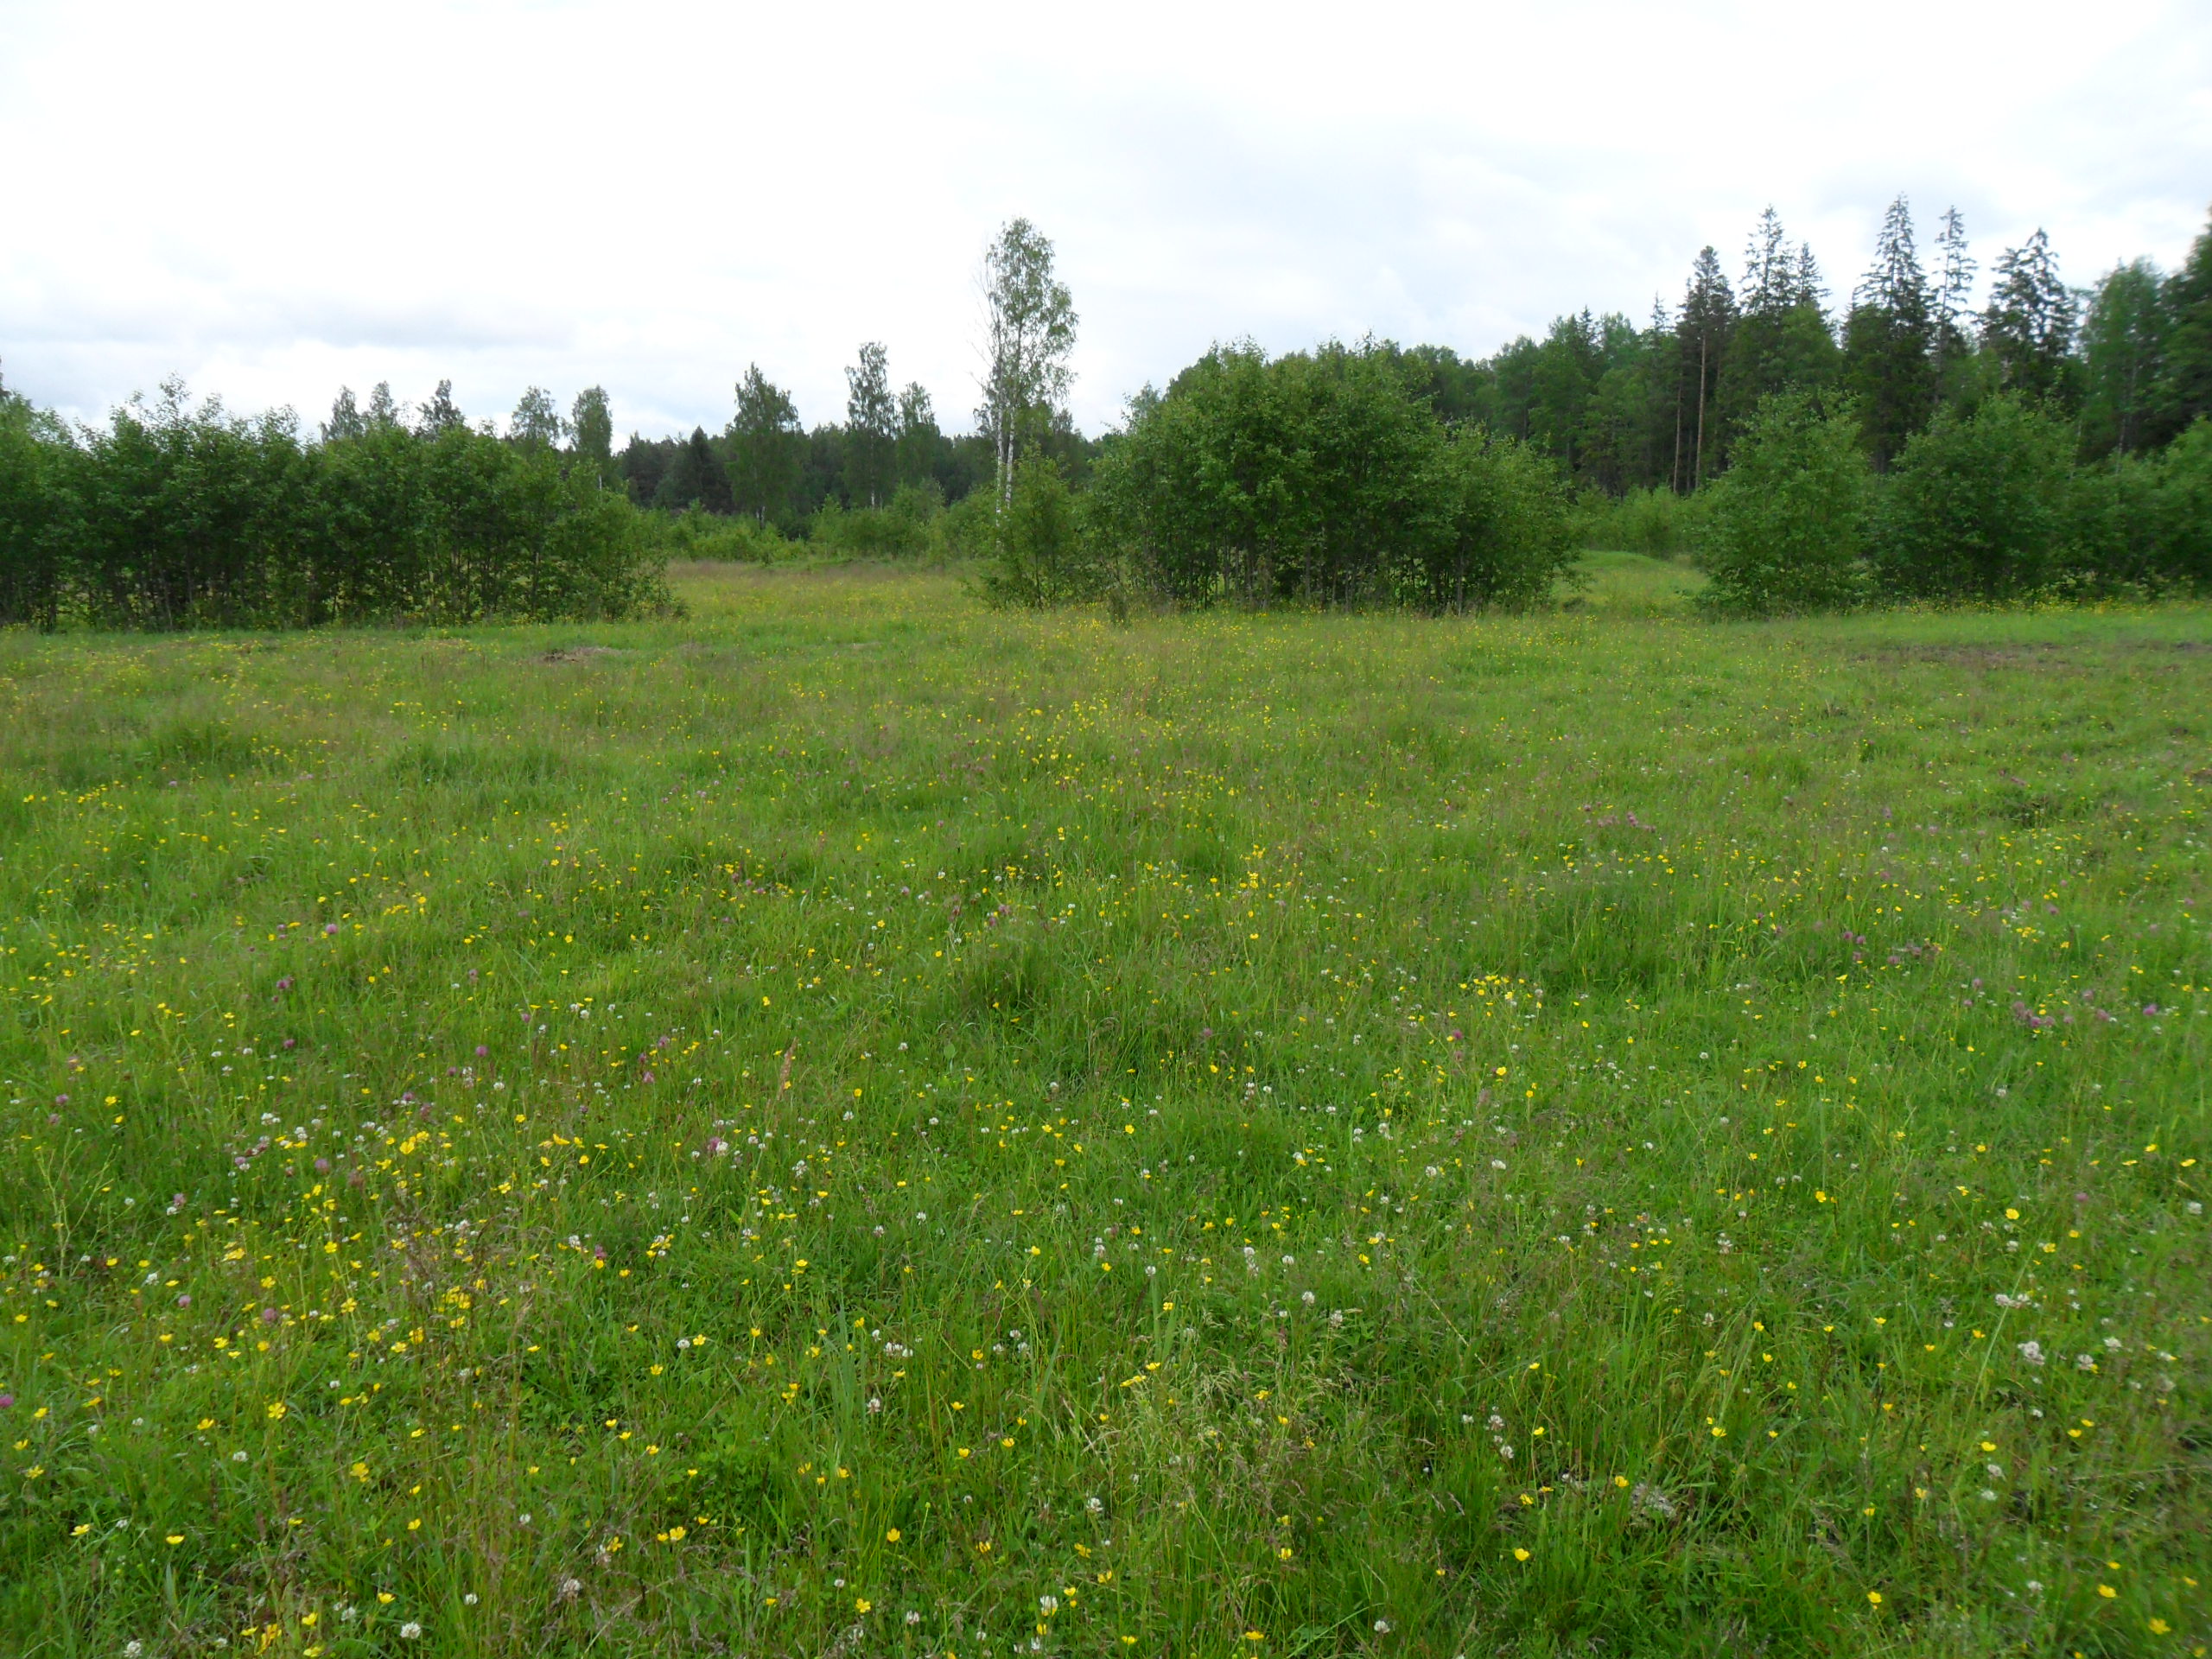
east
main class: Grassland
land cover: Spontaneously vegetated surfaces
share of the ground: > 75 %
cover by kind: herbaceous plants 90 %, shrubs 5 %
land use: Agriculture (excluding fallow land and kitchen gardens)
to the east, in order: Spontaneously vegetated surfaces; Abandoned hedges; Ditches and canals; Abandoned hedges; Grassland with sparse tree/shrub cover; Abandoned hedges; Ditches and canals; Abandoned hedges; Grassland with sparse tree/shrub cover; Abandoned hedges; Ditches and canals; Abandoned hedges; Grassland with sparse tree/shrub cover; Abandoned hedges; Ditches and canals; Abandoned hedges; Grassland with sparse tree/shrub cover; Abandoned hedges; Fences; Lines of trees; Tracks; Grass margins; Fences; Grassland without tree/shrub cover
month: June
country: LV
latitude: 57.4430
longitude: 22.1943
